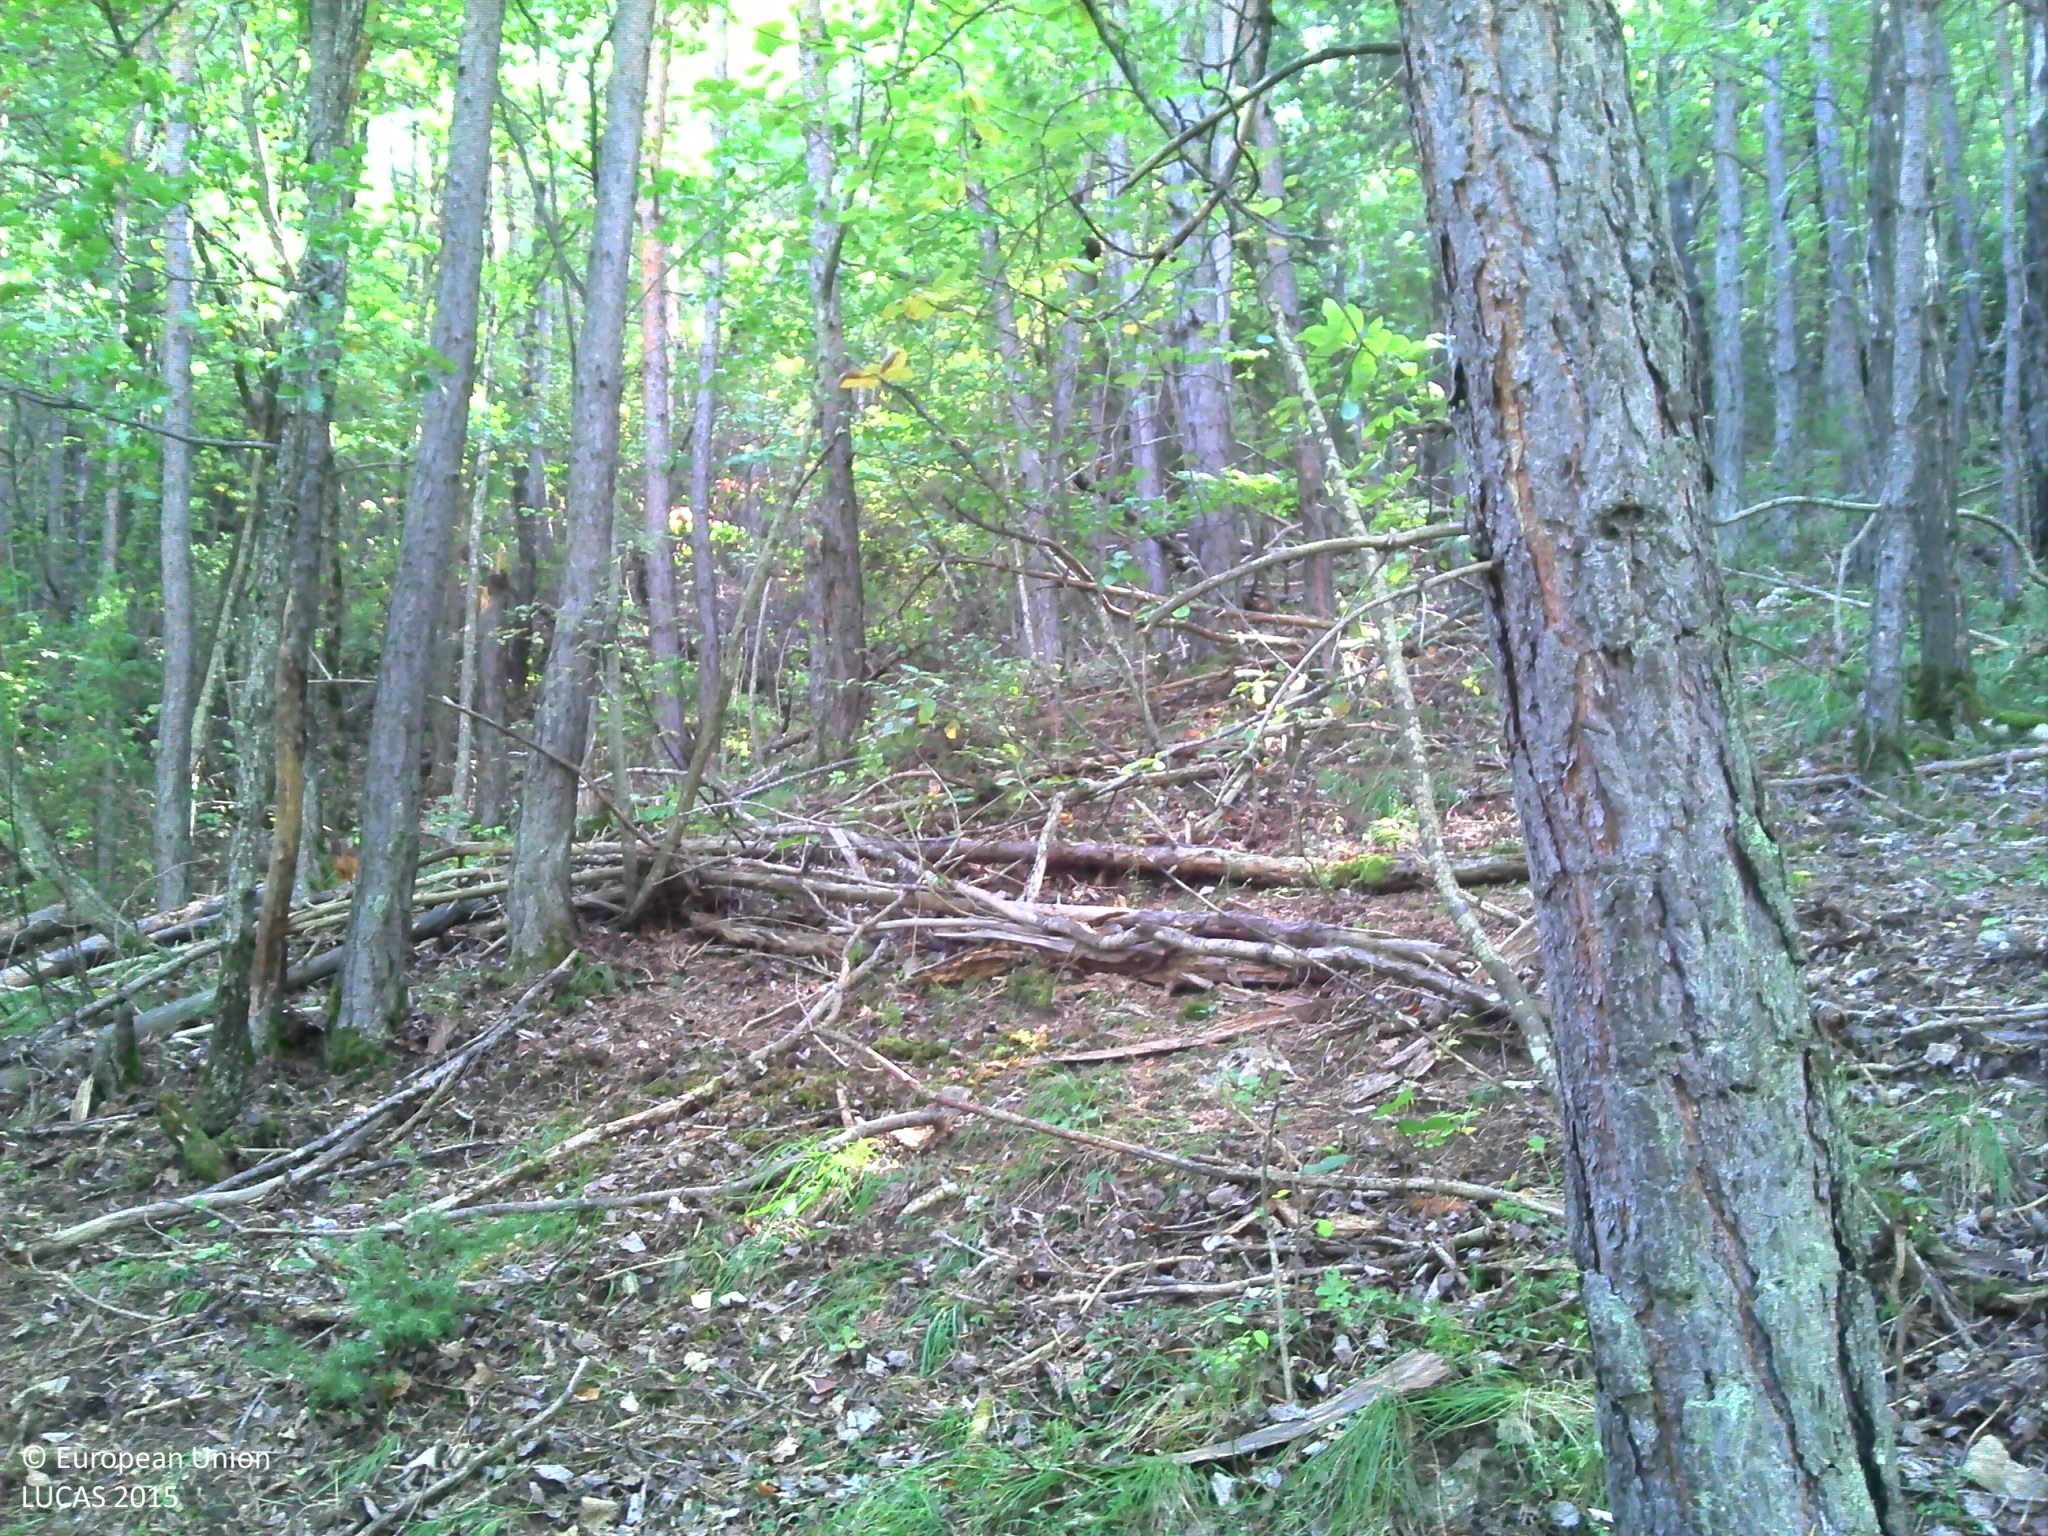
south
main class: Woodland
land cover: Pine dominated mixed woodland
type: hemiboreal forest and nemoral coniferous forest and mixed broadleaved-coniferous forest
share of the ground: > 75 %
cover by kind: coniferous forest trees 60 %, broadleaved forest trees 30 %, herbaceous plants 5 %, unconsolidated bare surface 5 %
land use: Forestry
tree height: > 5 m
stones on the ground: < 10 %
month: September
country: FR
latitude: 44.5235
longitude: 6.4205
